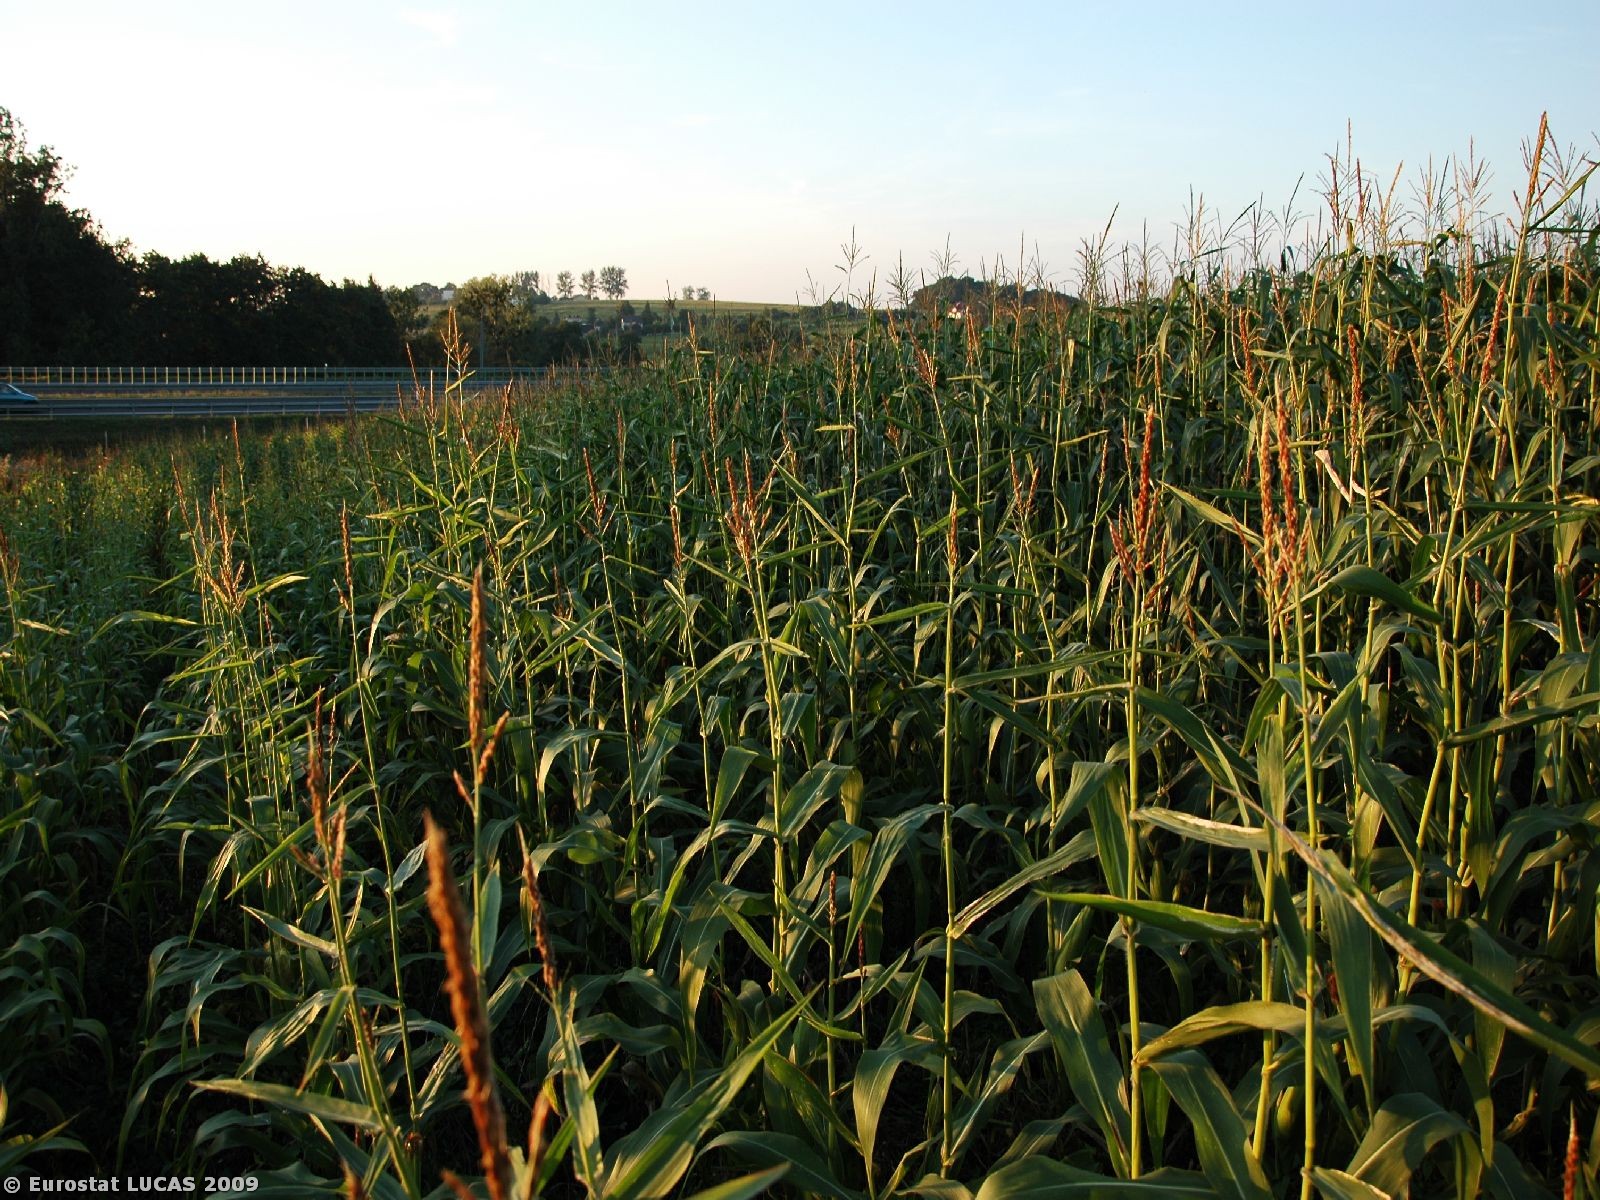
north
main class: Cropland
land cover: Maize
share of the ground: > 75 %
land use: Agriculture (excluding fallow land and kitchen gardens)
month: August
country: PL
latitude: 49.7767
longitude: 18.7274
